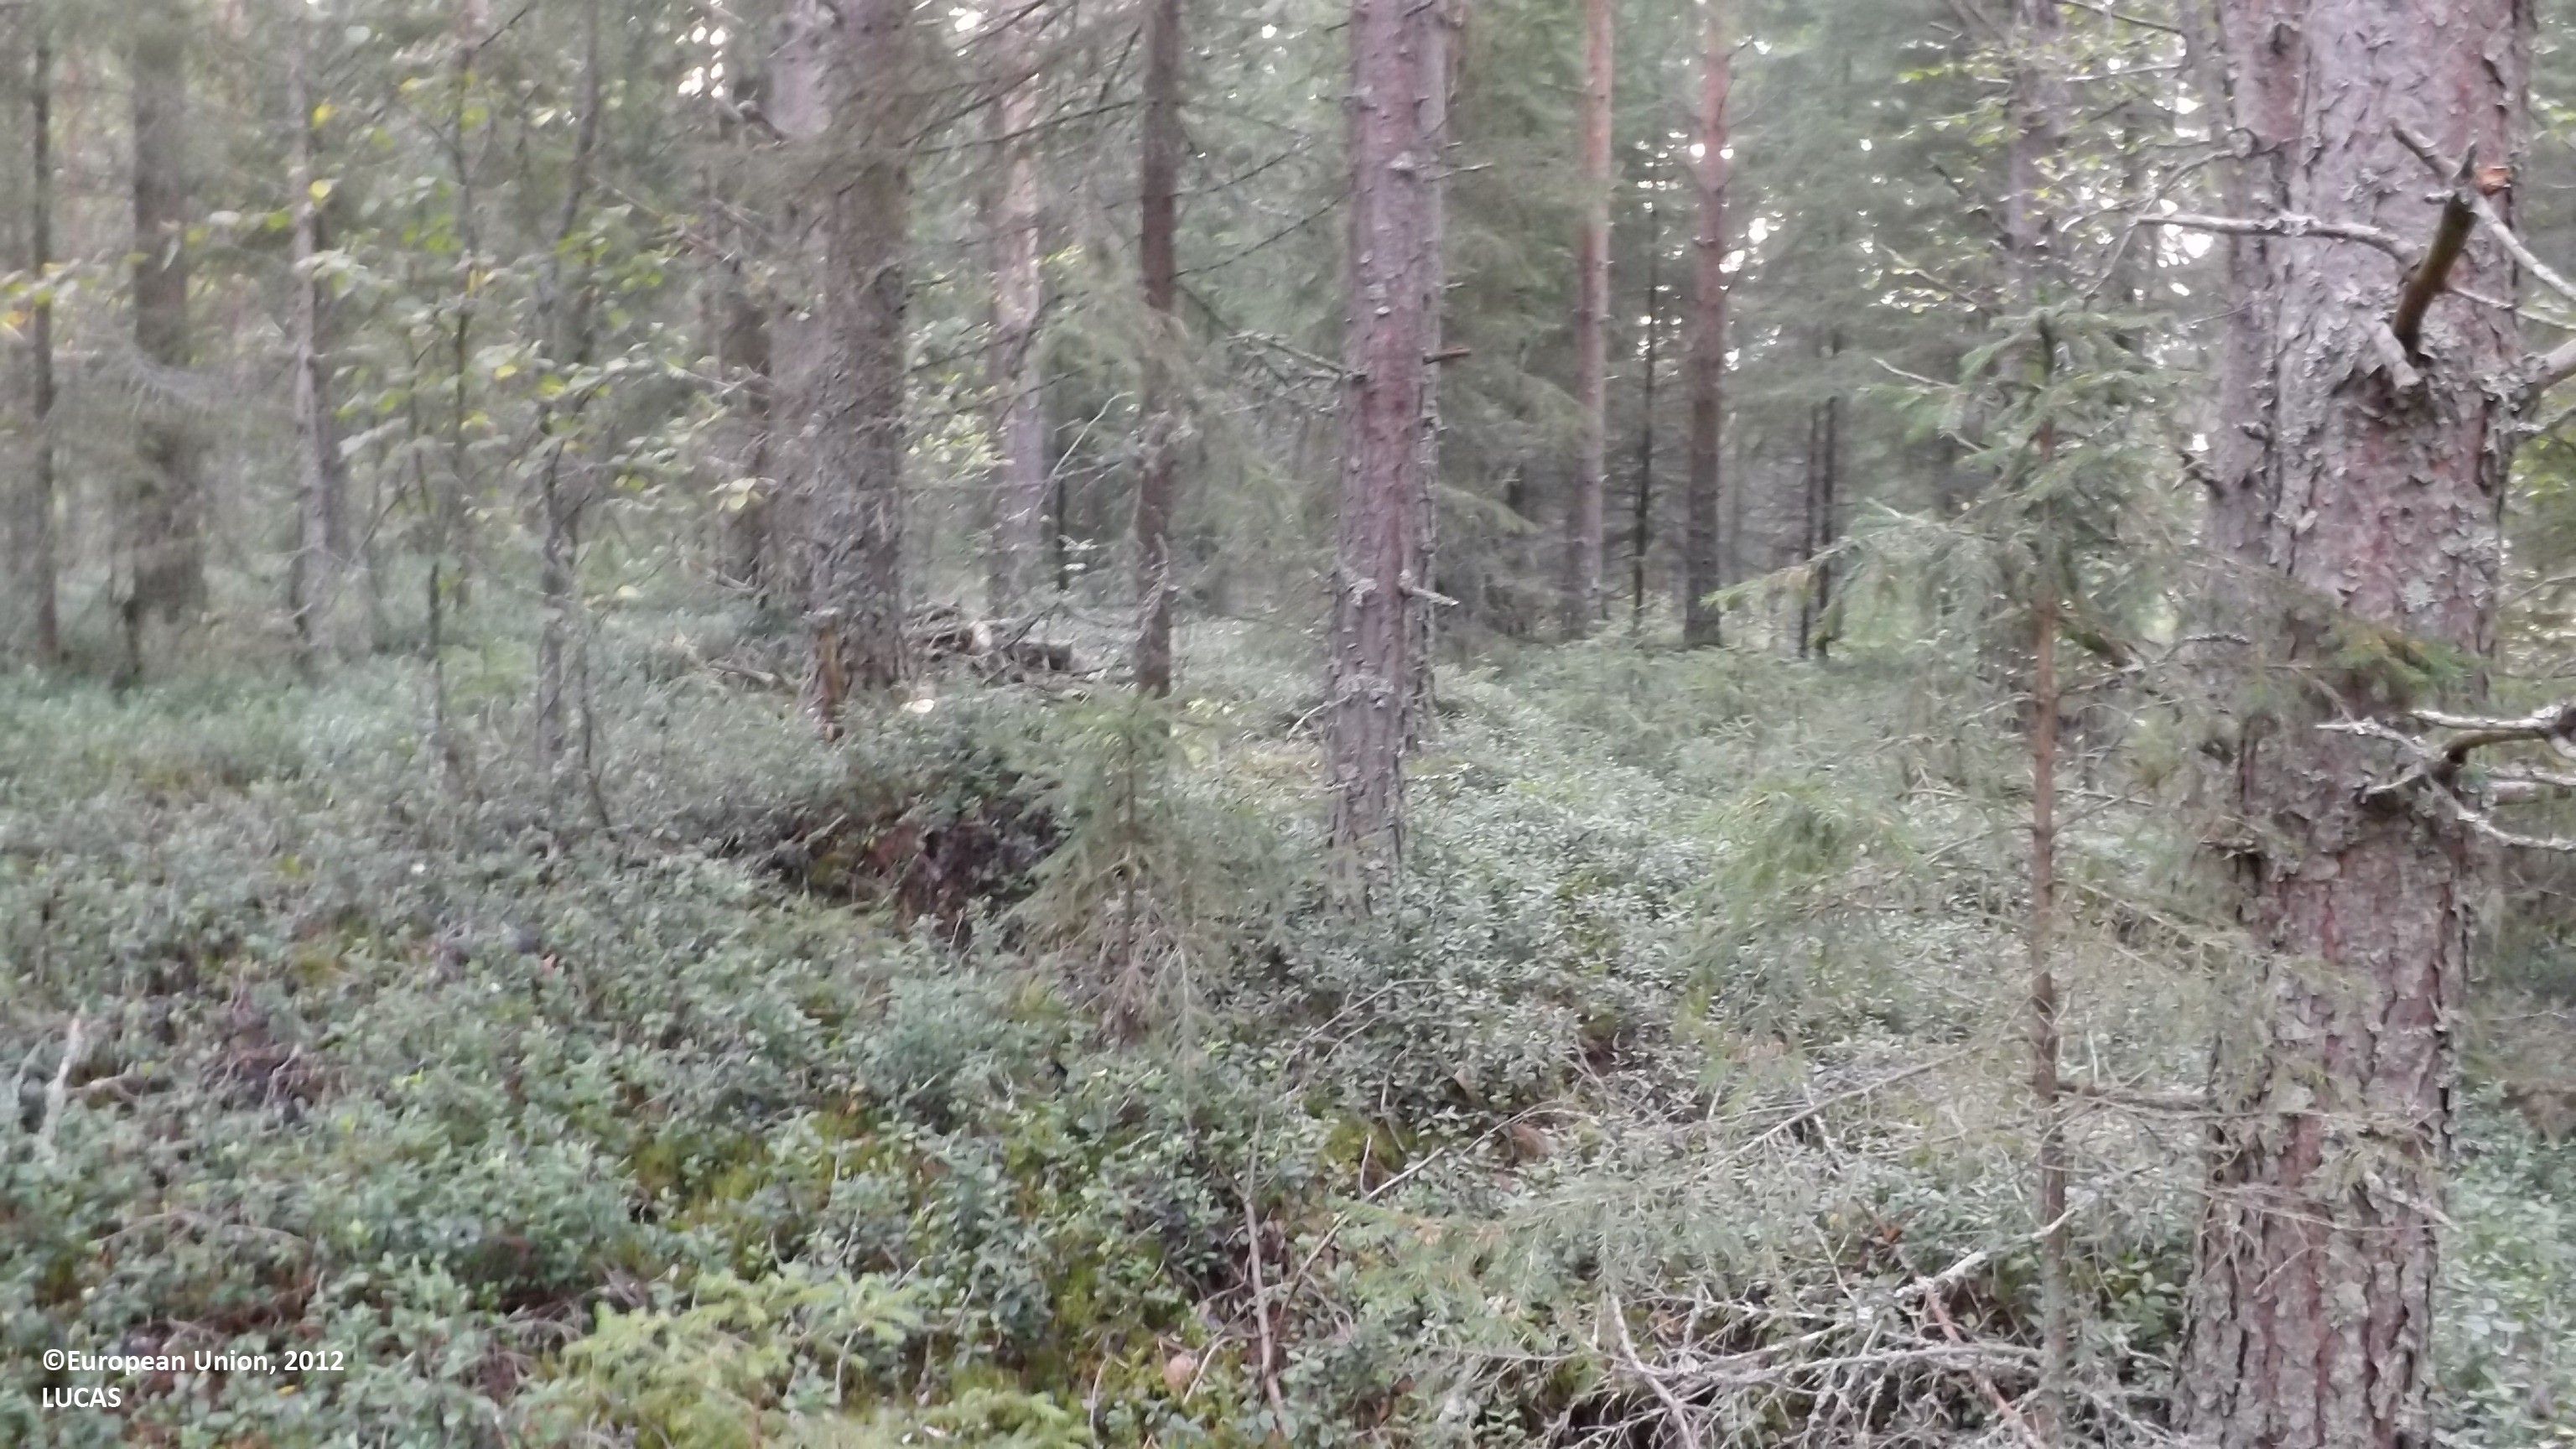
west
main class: Woodland
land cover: Pine dominated mixed woodland
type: boreal forest
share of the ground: 50 - 75 %
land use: Forestry
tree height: > 5 m
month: August
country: FI
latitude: 63.8227
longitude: 23.4470
